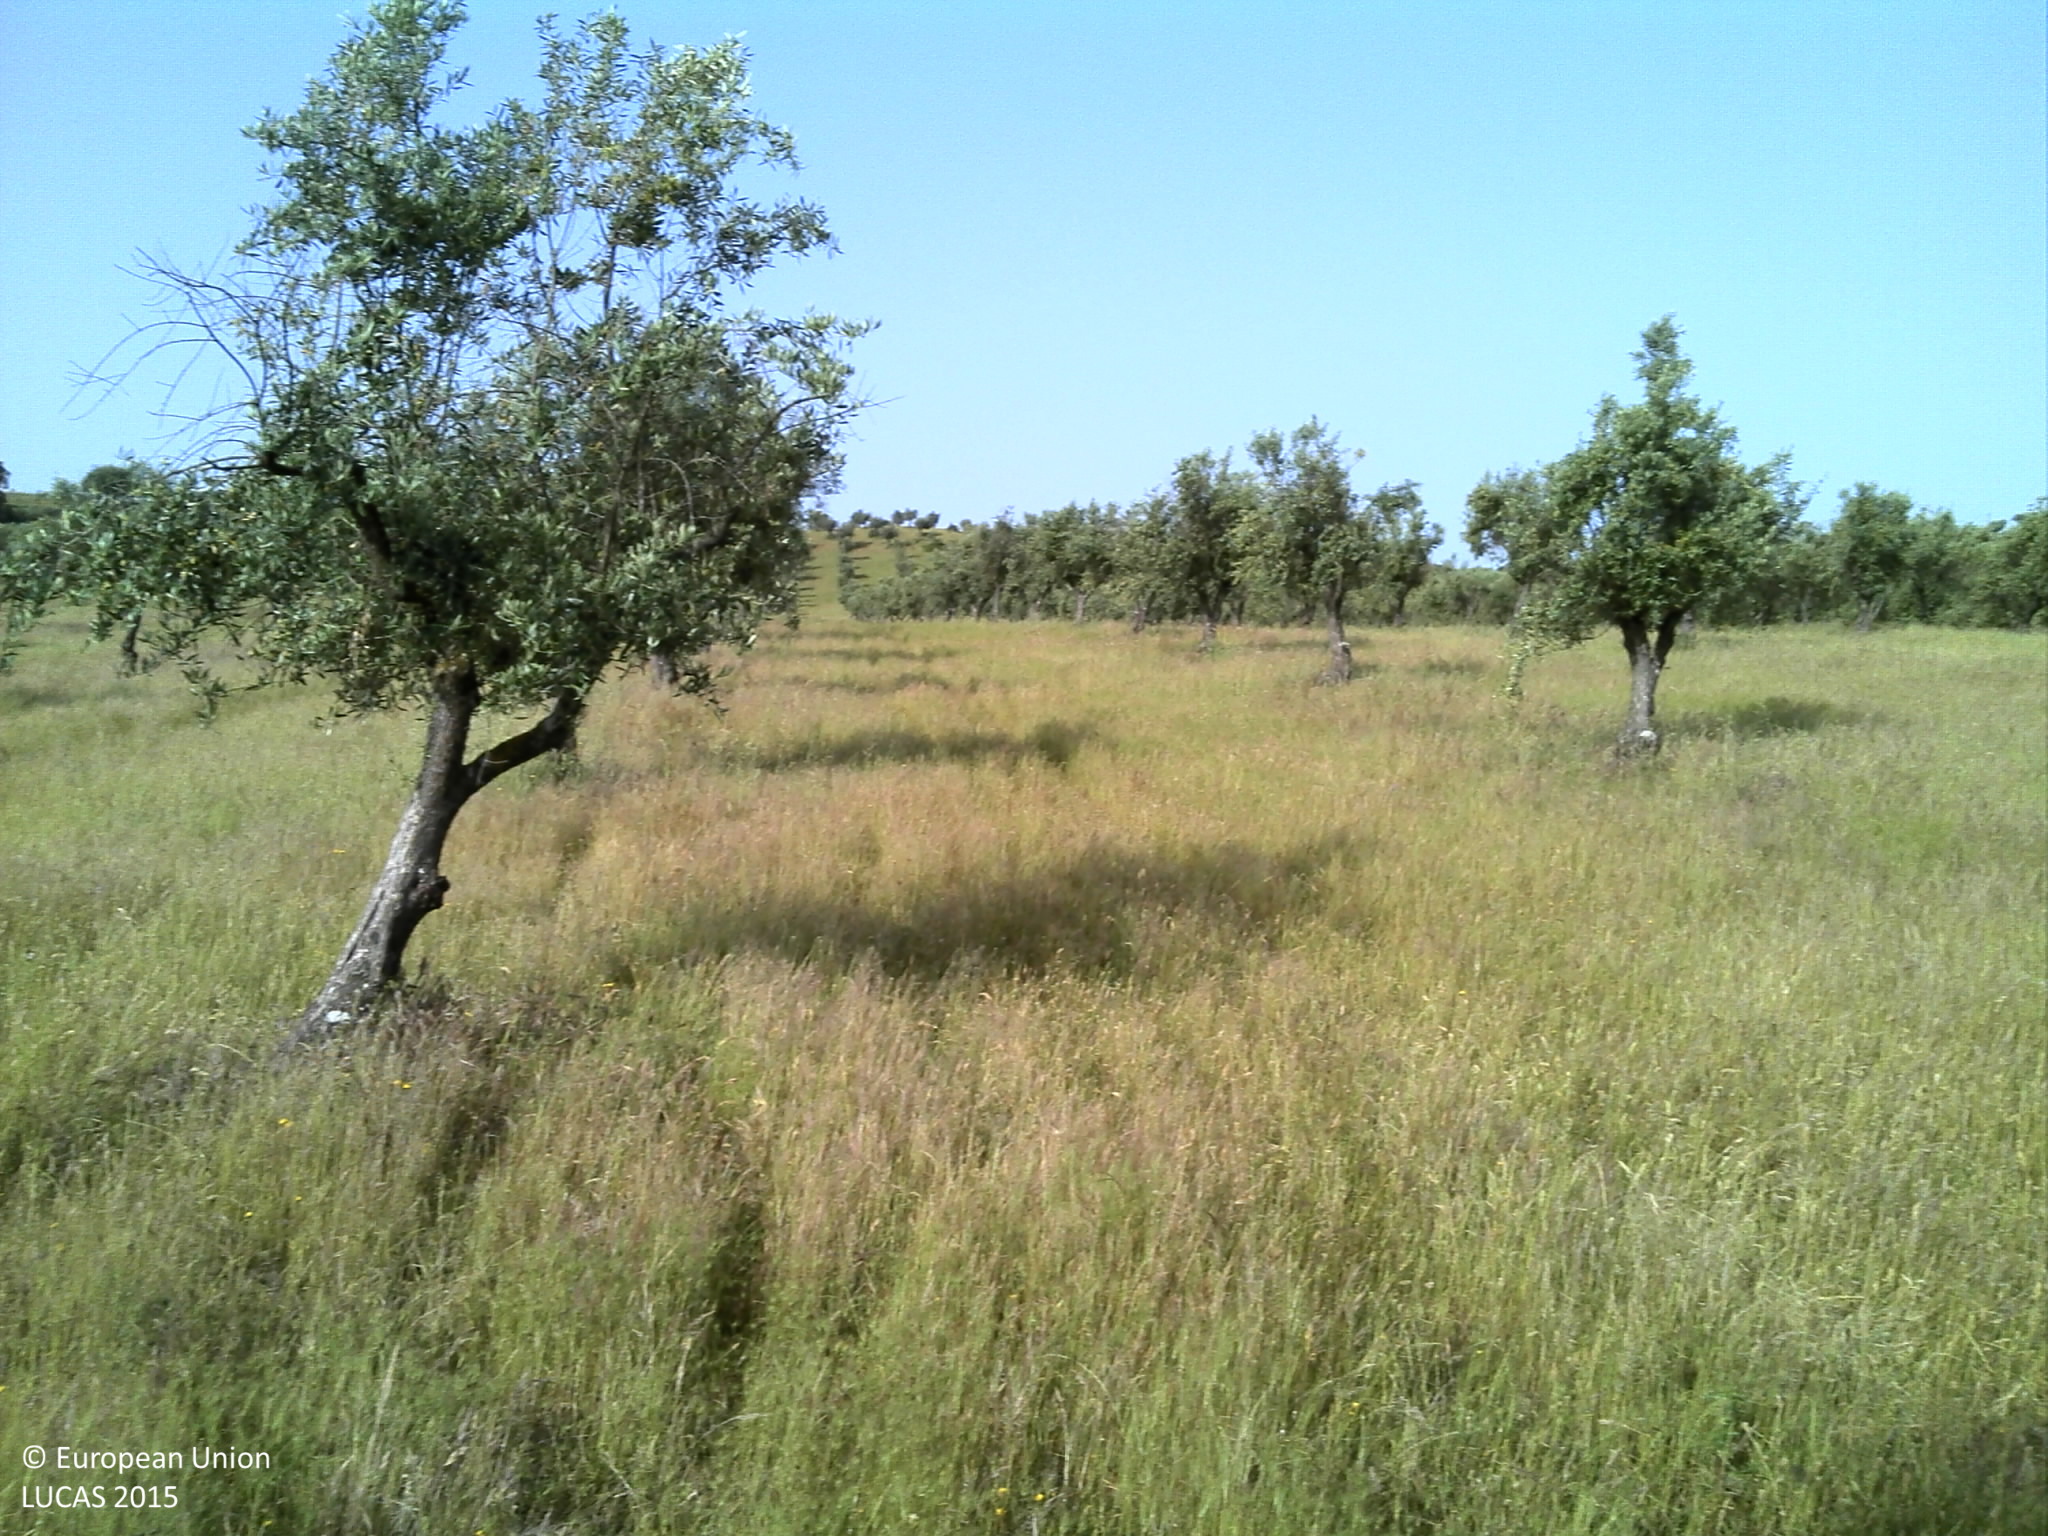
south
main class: Cropland
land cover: Olive groves
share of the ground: 25 - 50 %
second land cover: Grassland without tree/shrub cover
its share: 50 - 75 %
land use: Agriculture (excluding fallow land and kitchen gardens)
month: May
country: PT
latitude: 39.0136
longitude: -7.7958
